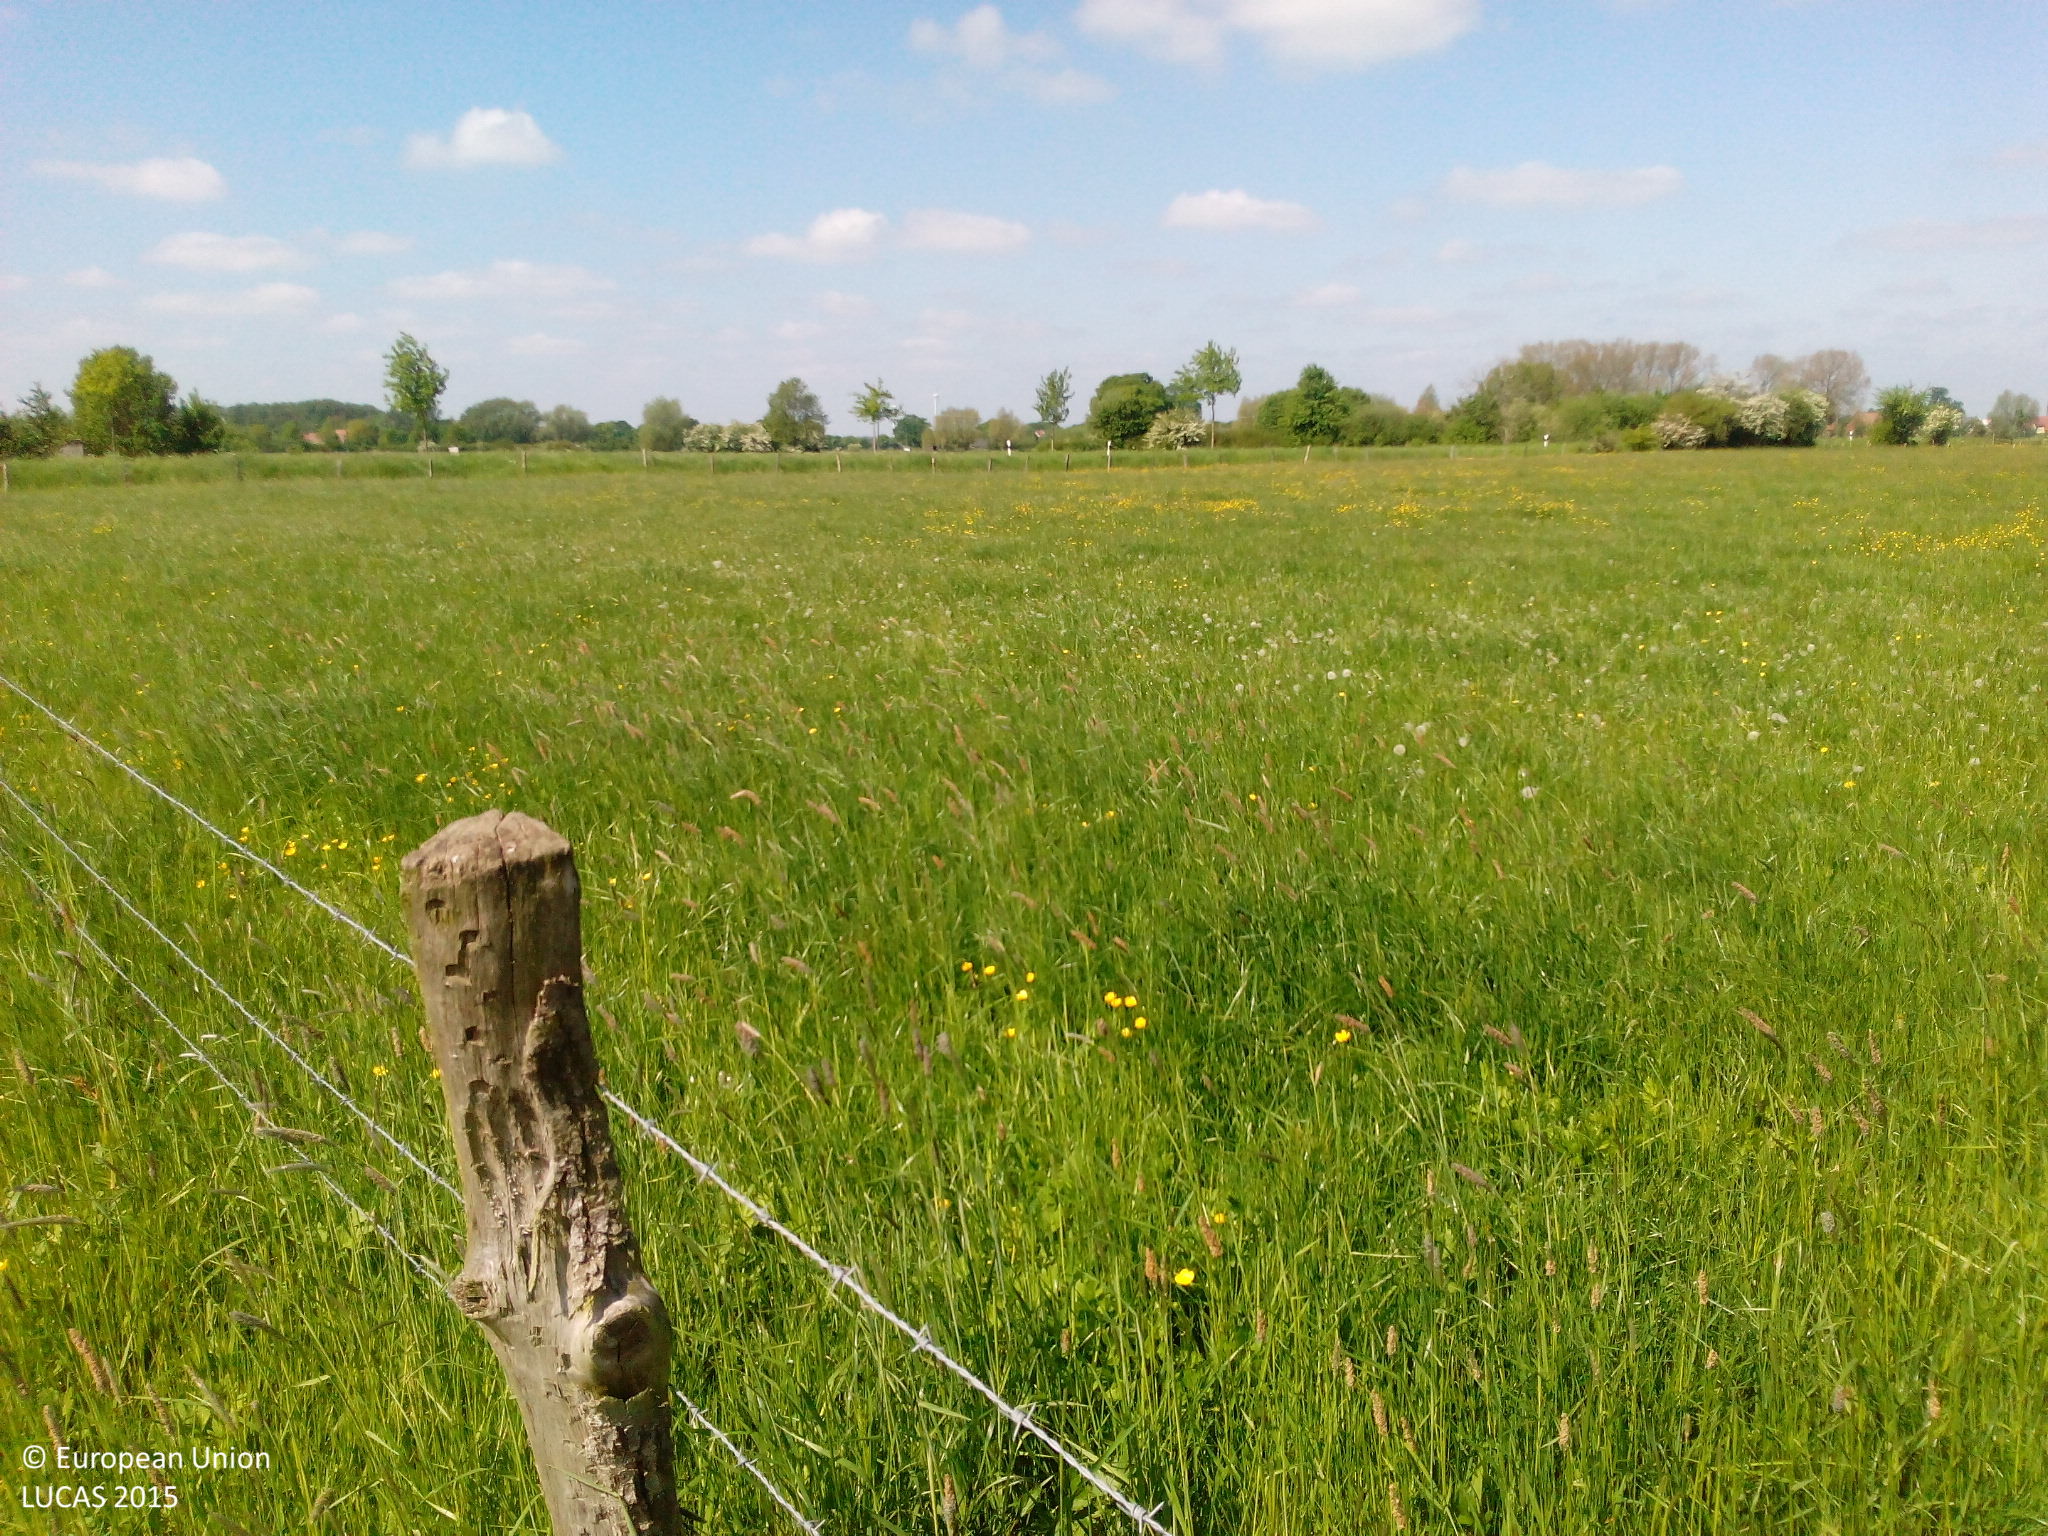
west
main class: Grassland
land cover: Grassland without tree/shrub cover
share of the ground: > 75 %
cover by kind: herbaceous plants 100 %
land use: Agriculture (excluding fallow land and kitchen gardens)
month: May
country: DE
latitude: 51.9108
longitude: 7.9798
